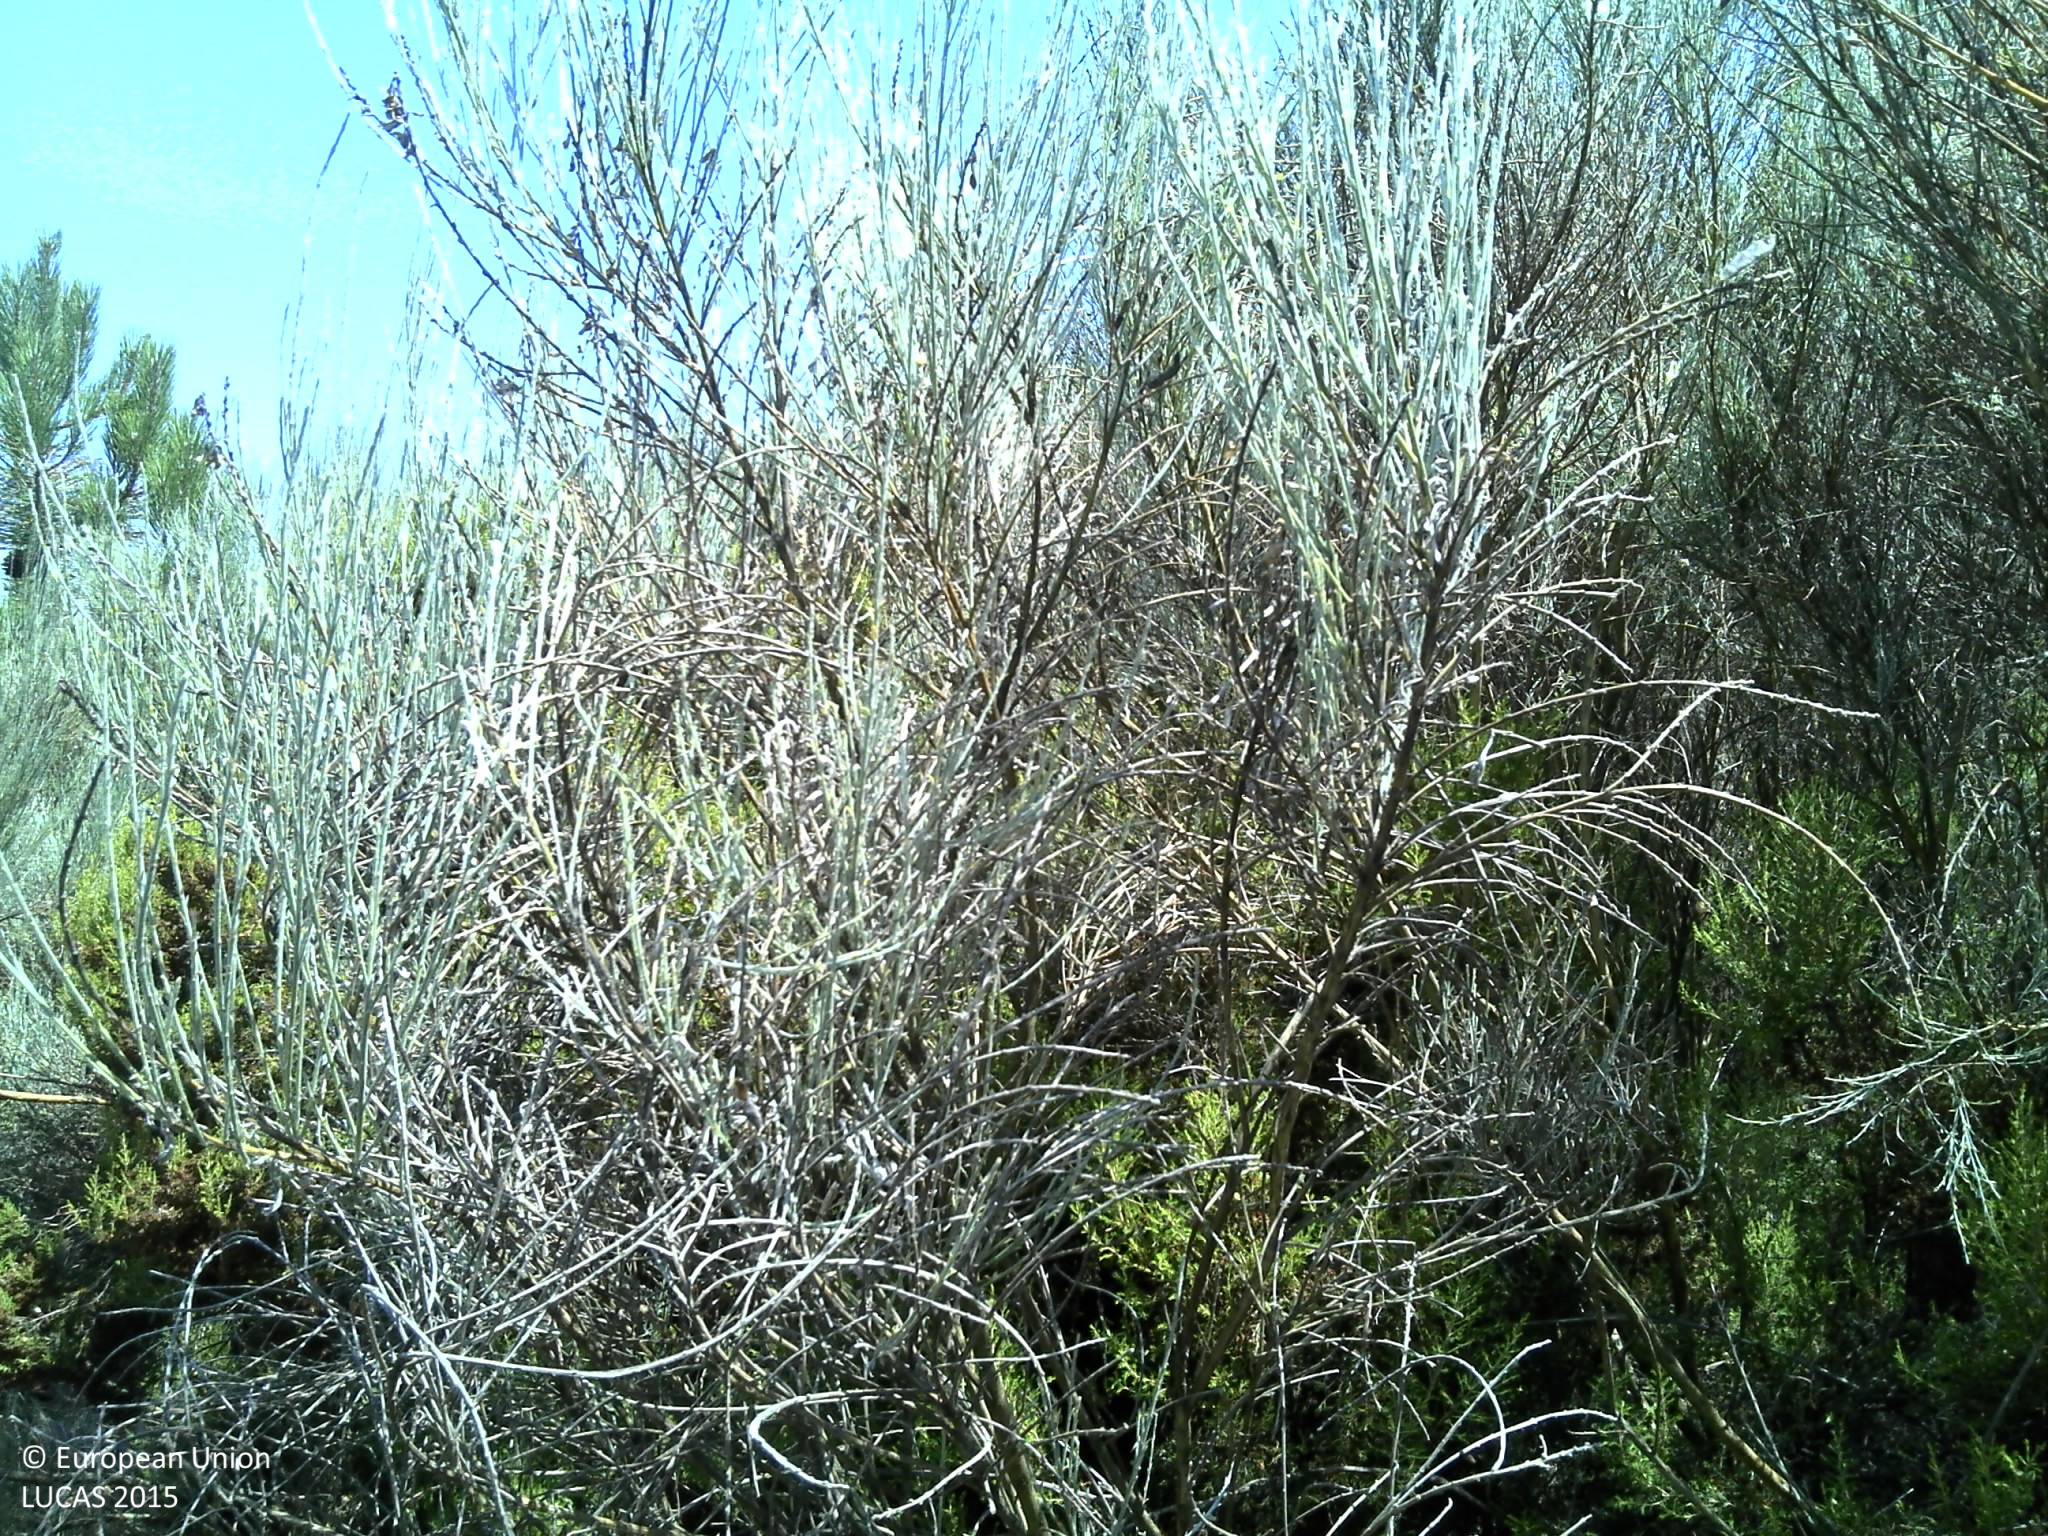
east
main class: Shrubland
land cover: Shrubland without tree cover
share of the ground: > 75 %
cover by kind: shrubs 90 %, herbaceous plants 5 %, consolidated bare surface 5 %
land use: Semi-natural and natural areas not in use
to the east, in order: Shrubland without tree cover; Rock outcrops; Shrubland with sparse tree cover; Rock outcrops; Shrubland with sparse tree cover; Broadleaved woodland
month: July
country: PT
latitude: 40.8455
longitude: -7.4683
